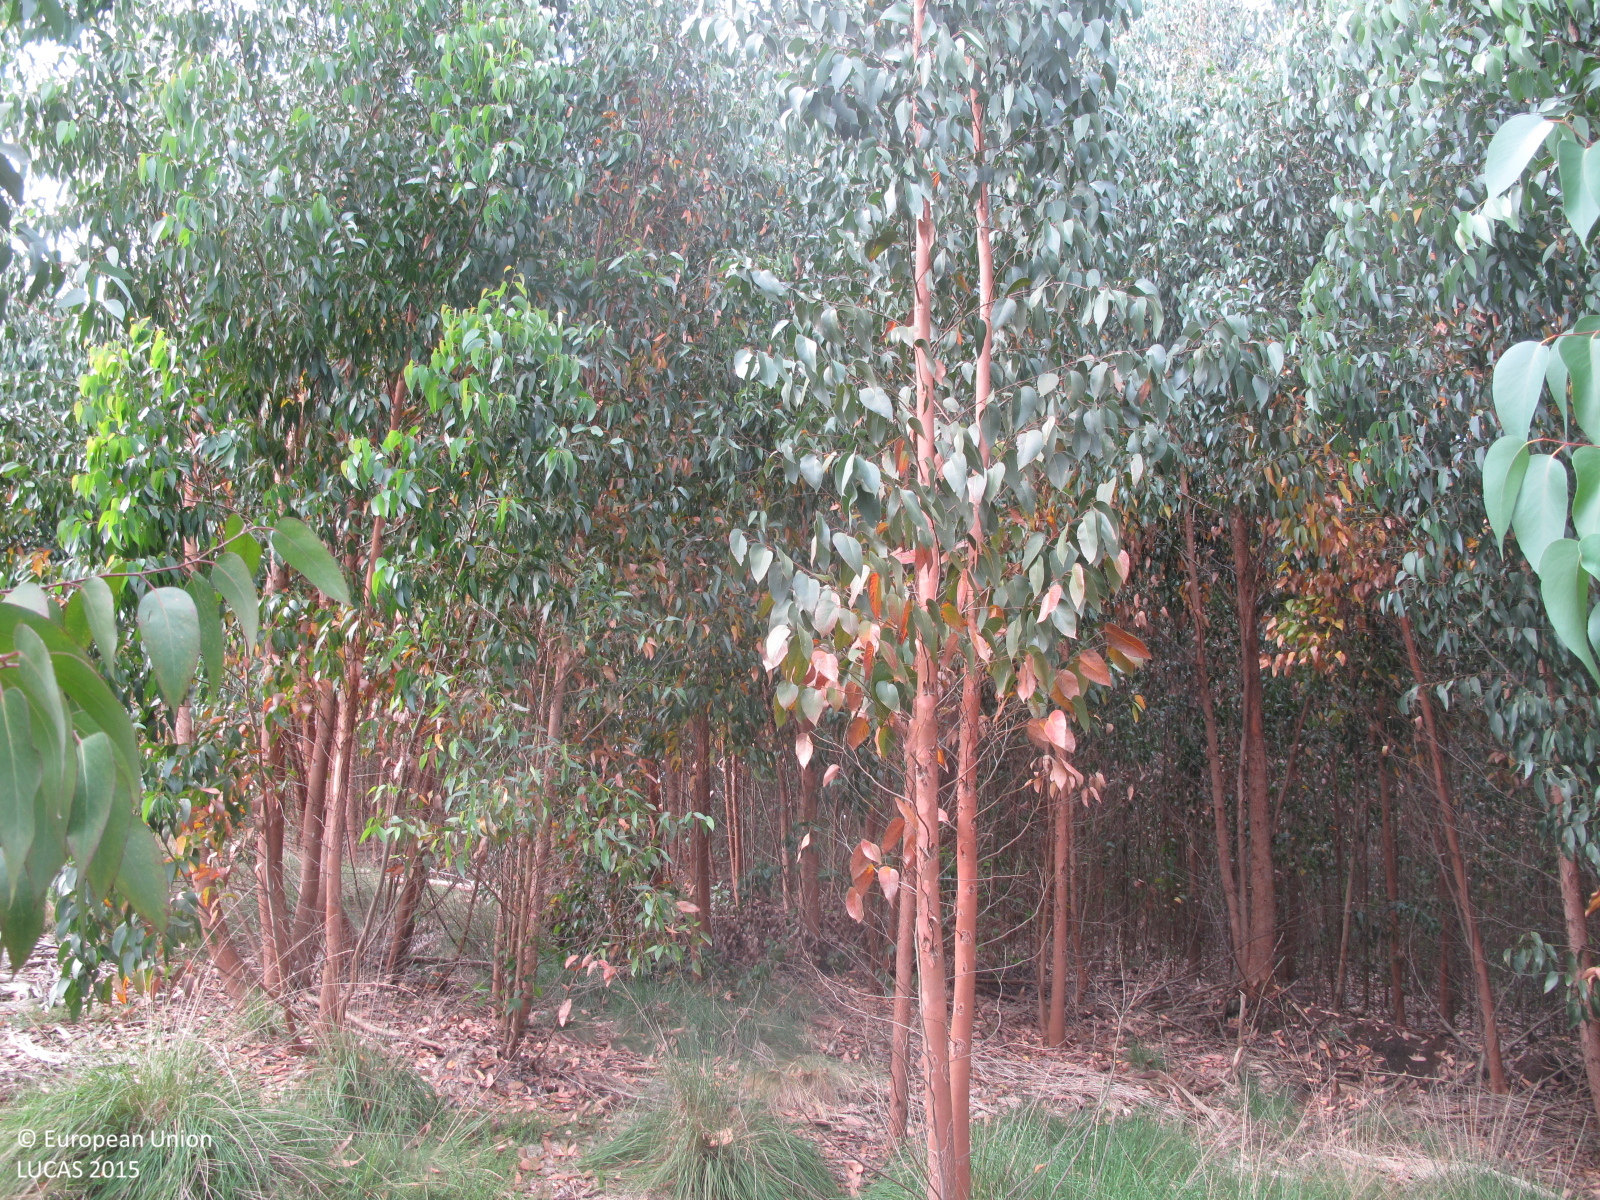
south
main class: Woodland
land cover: Broadleaved woodland
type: exotic forest
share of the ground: 50 - 75 %
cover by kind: broadleaved forest trees 60 %, unconsolidated bare surface 20 %, shrubs 10 %, herbaceous plants 10 %
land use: Forestry
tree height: > 5 m
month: July
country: ES
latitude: 43.2951
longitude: -8.1048
